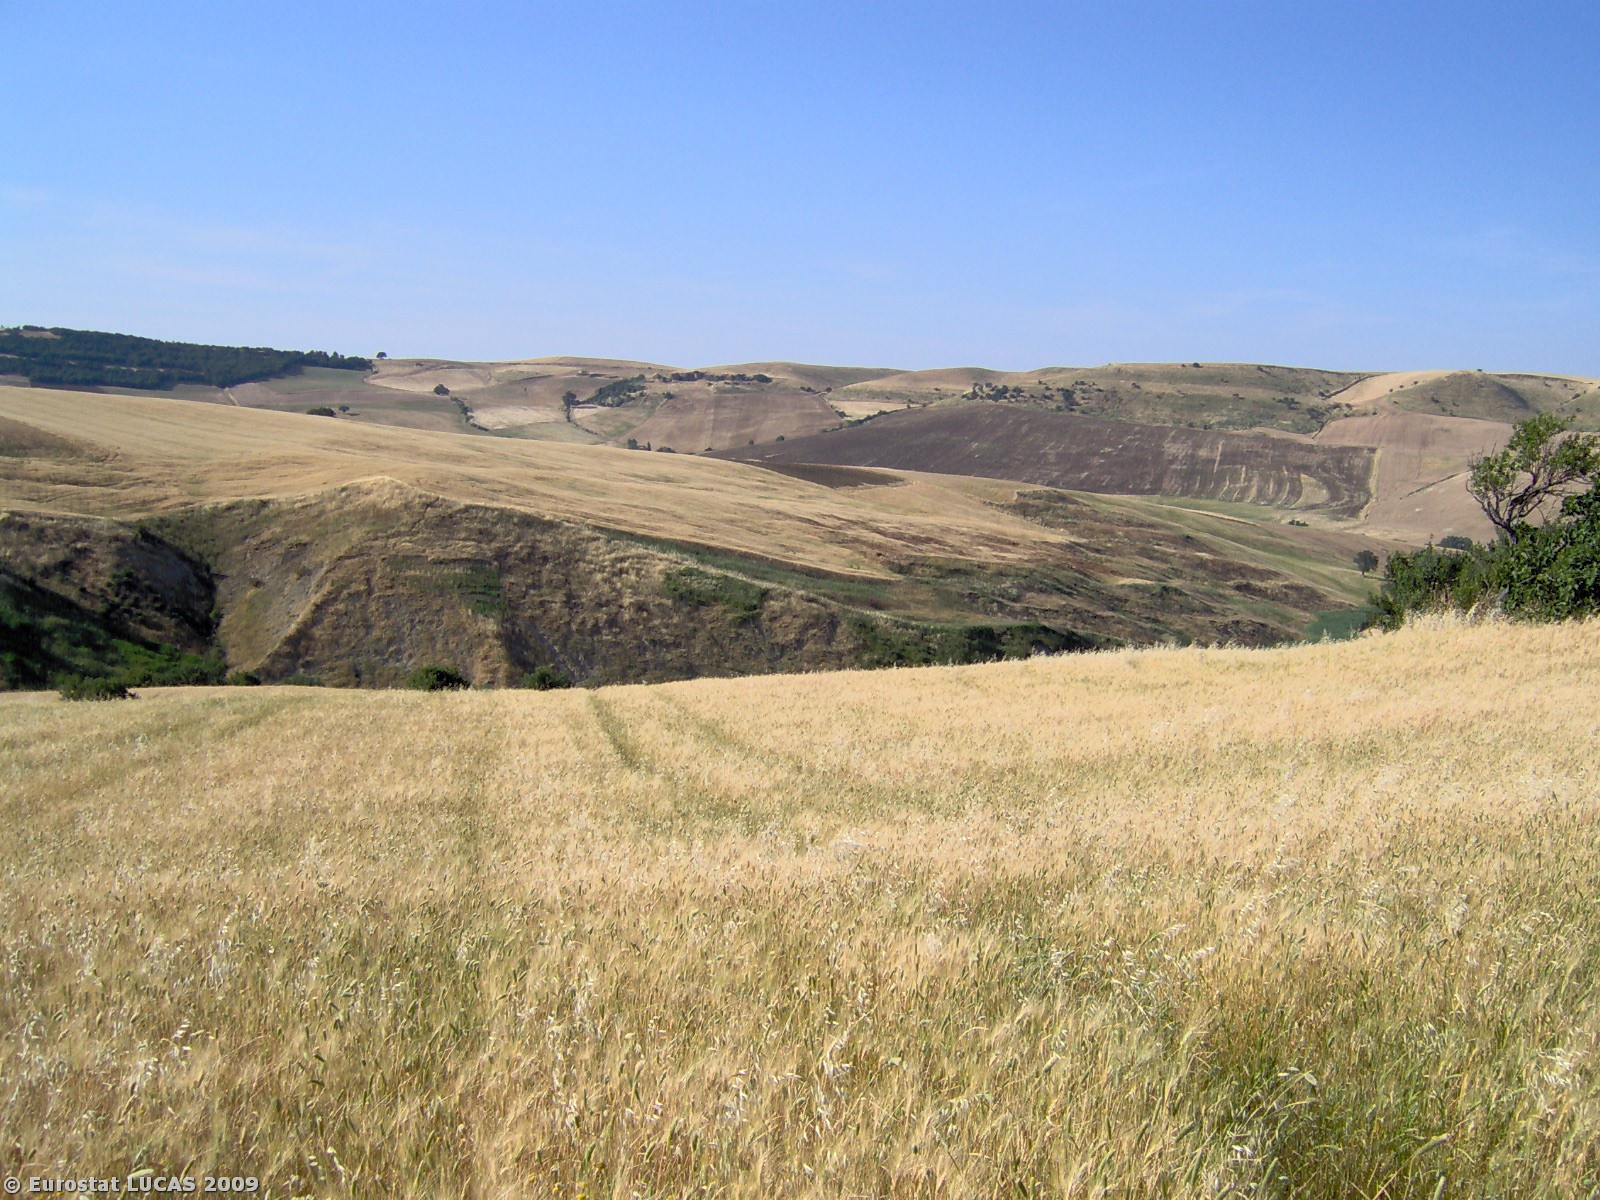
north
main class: Cropland
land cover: Durum wheat
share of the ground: > 75 %
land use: Agriculture (excluding fallow land and kitchen gardens)
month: June
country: IT
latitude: 40.8502
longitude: 15.9212
